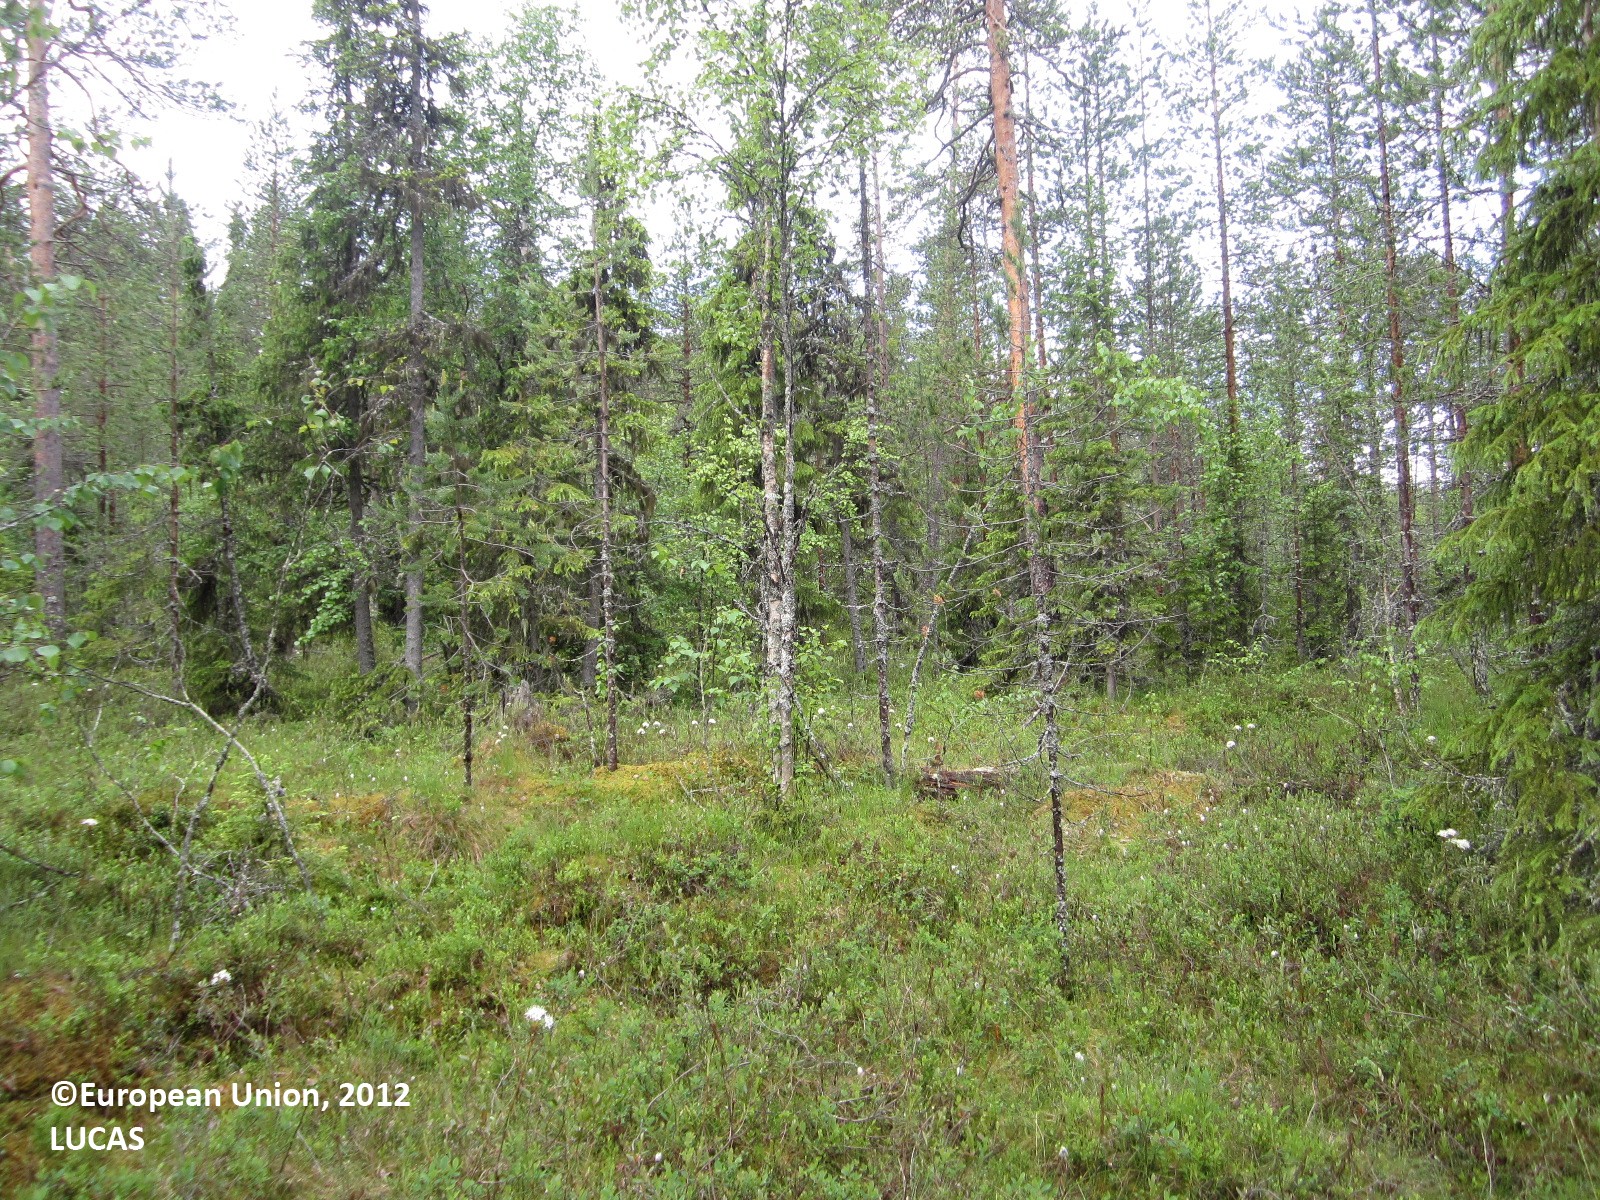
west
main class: Woodland
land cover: Spruce dominated coniferous woodland
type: mire and swamp forests
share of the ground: 50 - 75 %
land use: Forestry
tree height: > 5 m
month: June
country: FI
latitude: 64.5441
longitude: 29.5879
